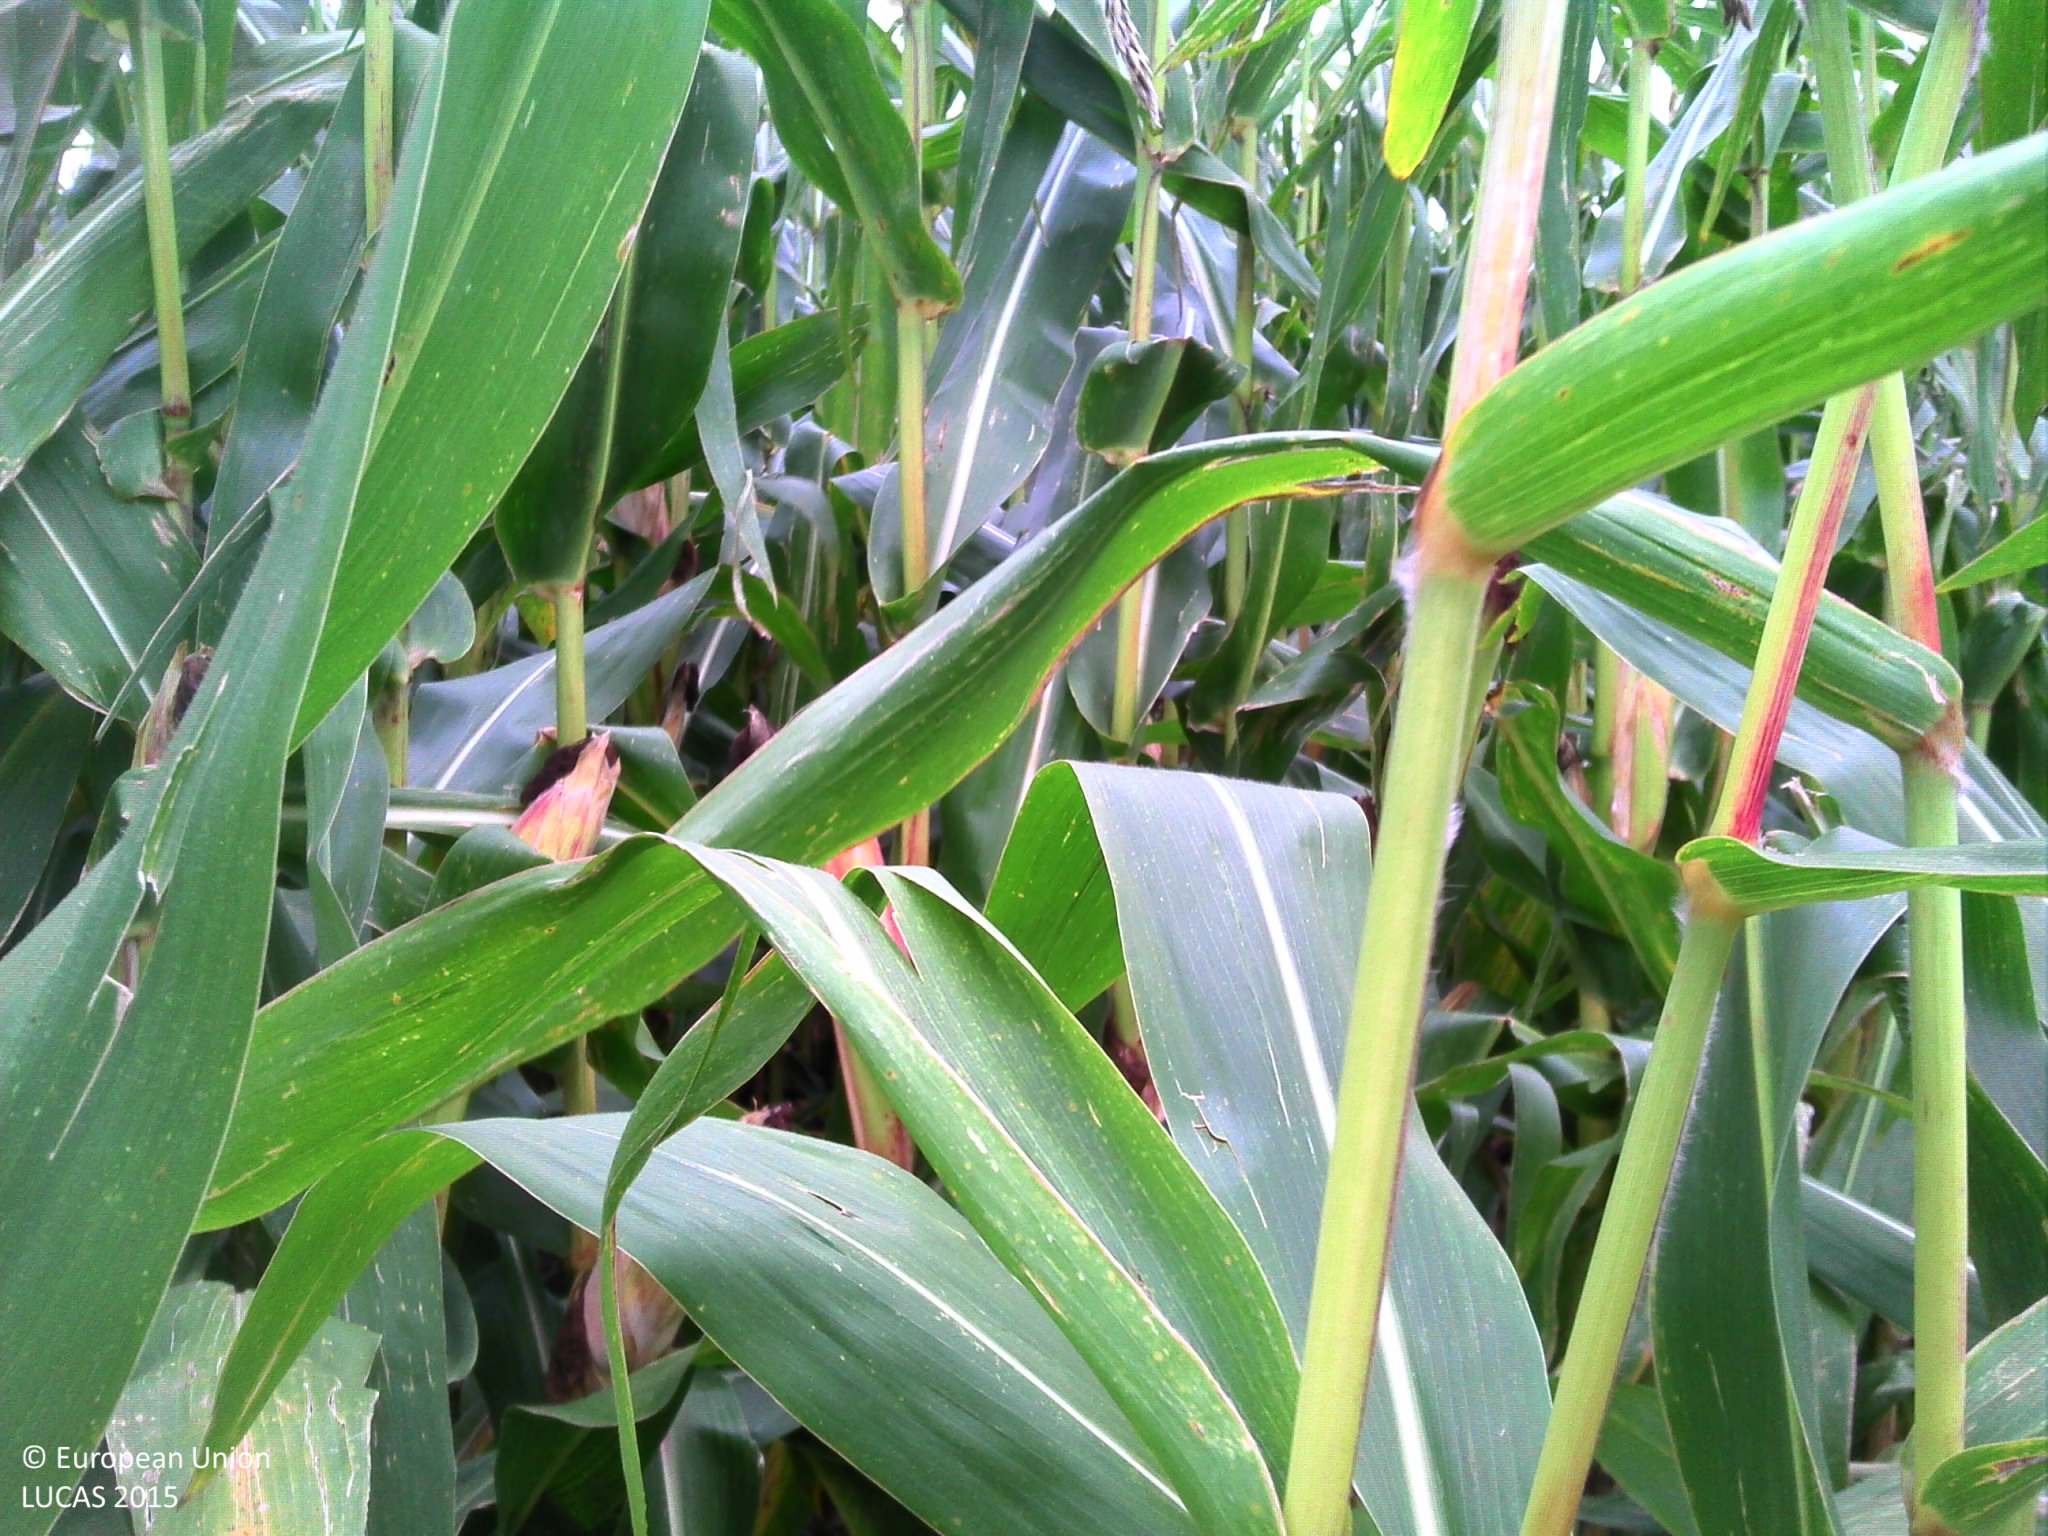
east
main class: Cropland
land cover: Maize
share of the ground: > 75 %
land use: Agriculture (excluding fallow land and kitchen gardens)
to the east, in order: Maize; Ditches and canals; Single bushes/trees; Grass margins; Maize; Fences; Grassland without tree/shrub cover; Inland fresh water bodies; Grassland without tree/shrub cover; Artificial constructions in urban areas; Grassland with sparse tree/shrub cover
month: September
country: BE
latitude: 51.1209
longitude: 2.9461
